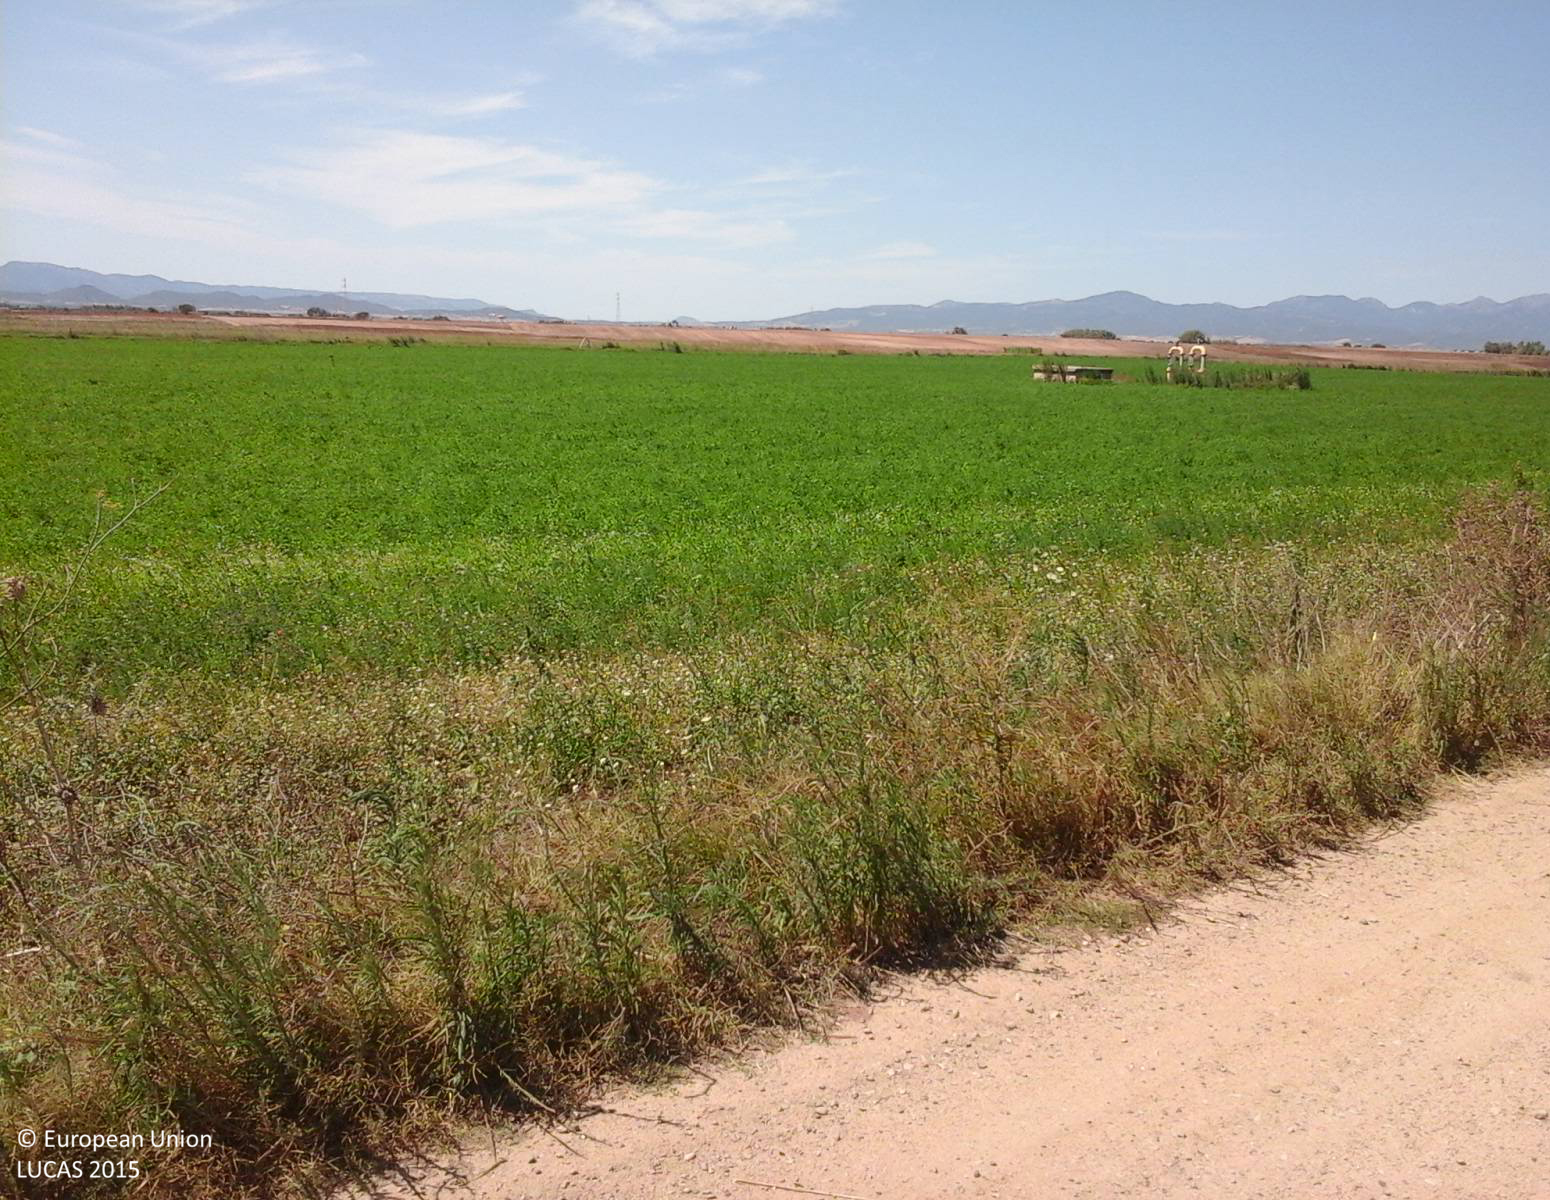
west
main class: Cropland
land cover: Durum wheat
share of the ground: > 75 %
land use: Agriculture (excluding fallow land and kitchen gardens)
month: August
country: IT
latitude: 39.4109
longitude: 8.9956
